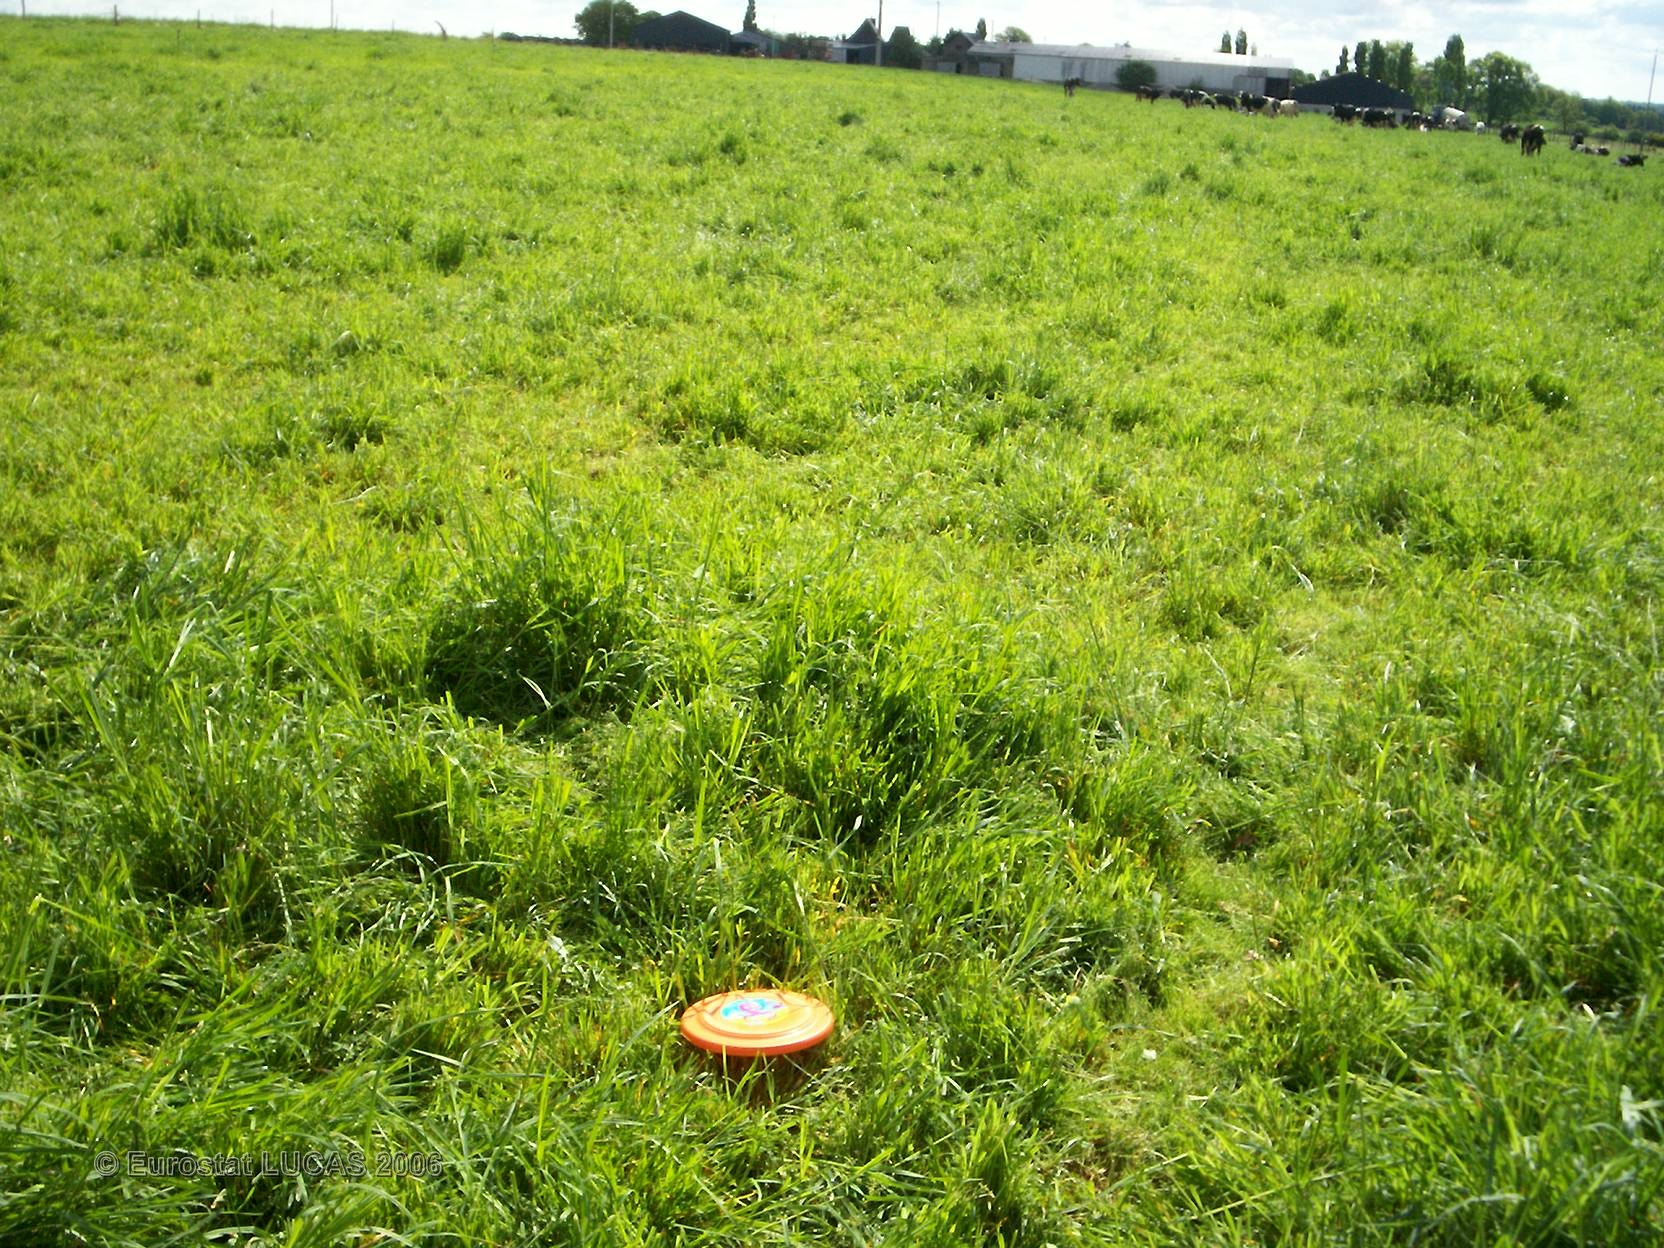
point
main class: Grassland
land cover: Grassland without tree/shrub cover
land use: Agriculture (excluding fallow land and kitchen gardens)
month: May
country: FR
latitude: 47.8260
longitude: -1.0861
